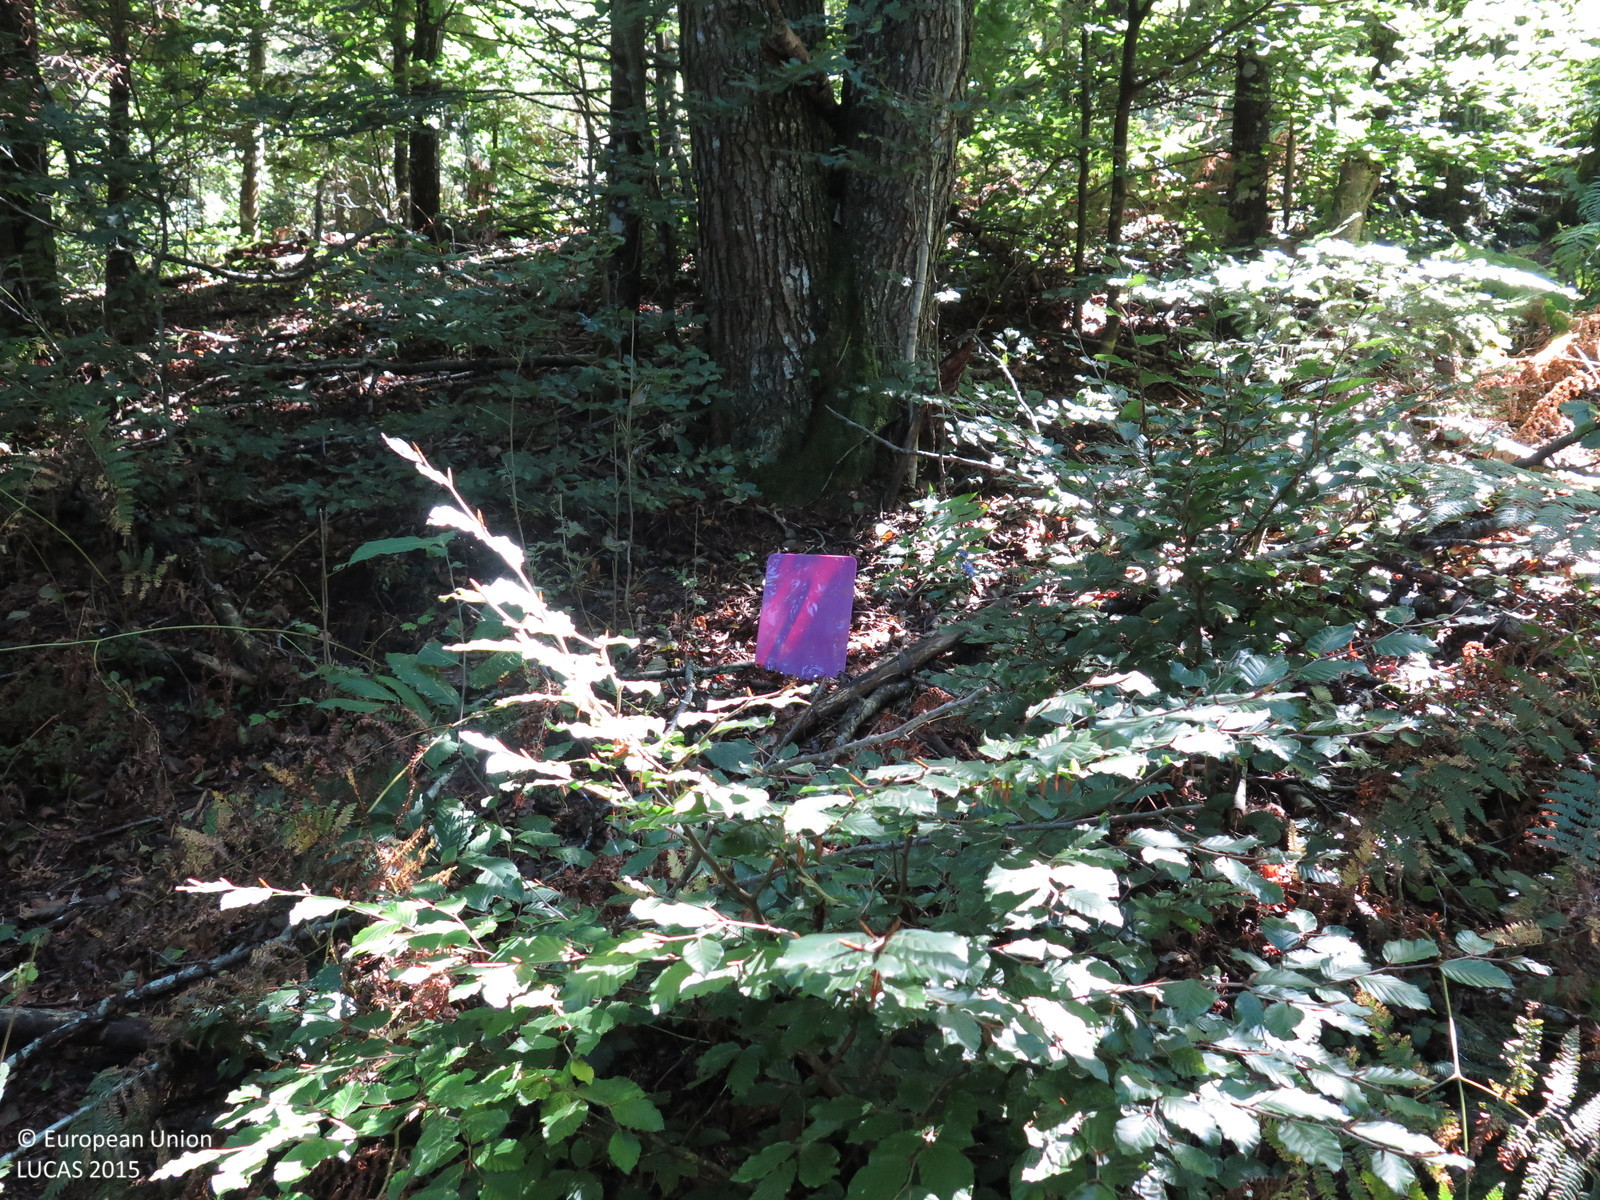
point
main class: Woodland
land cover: Broadleaved woodland
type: mountainous beech forest
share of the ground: > 75 %
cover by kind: broadleaved forest trees 90 %, shrubs 5 %, herbaceous plants 5 %
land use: Forestry
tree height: > 5 m
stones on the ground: 10 - 25 %
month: September
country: HR
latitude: 45.5635
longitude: 14.6720
